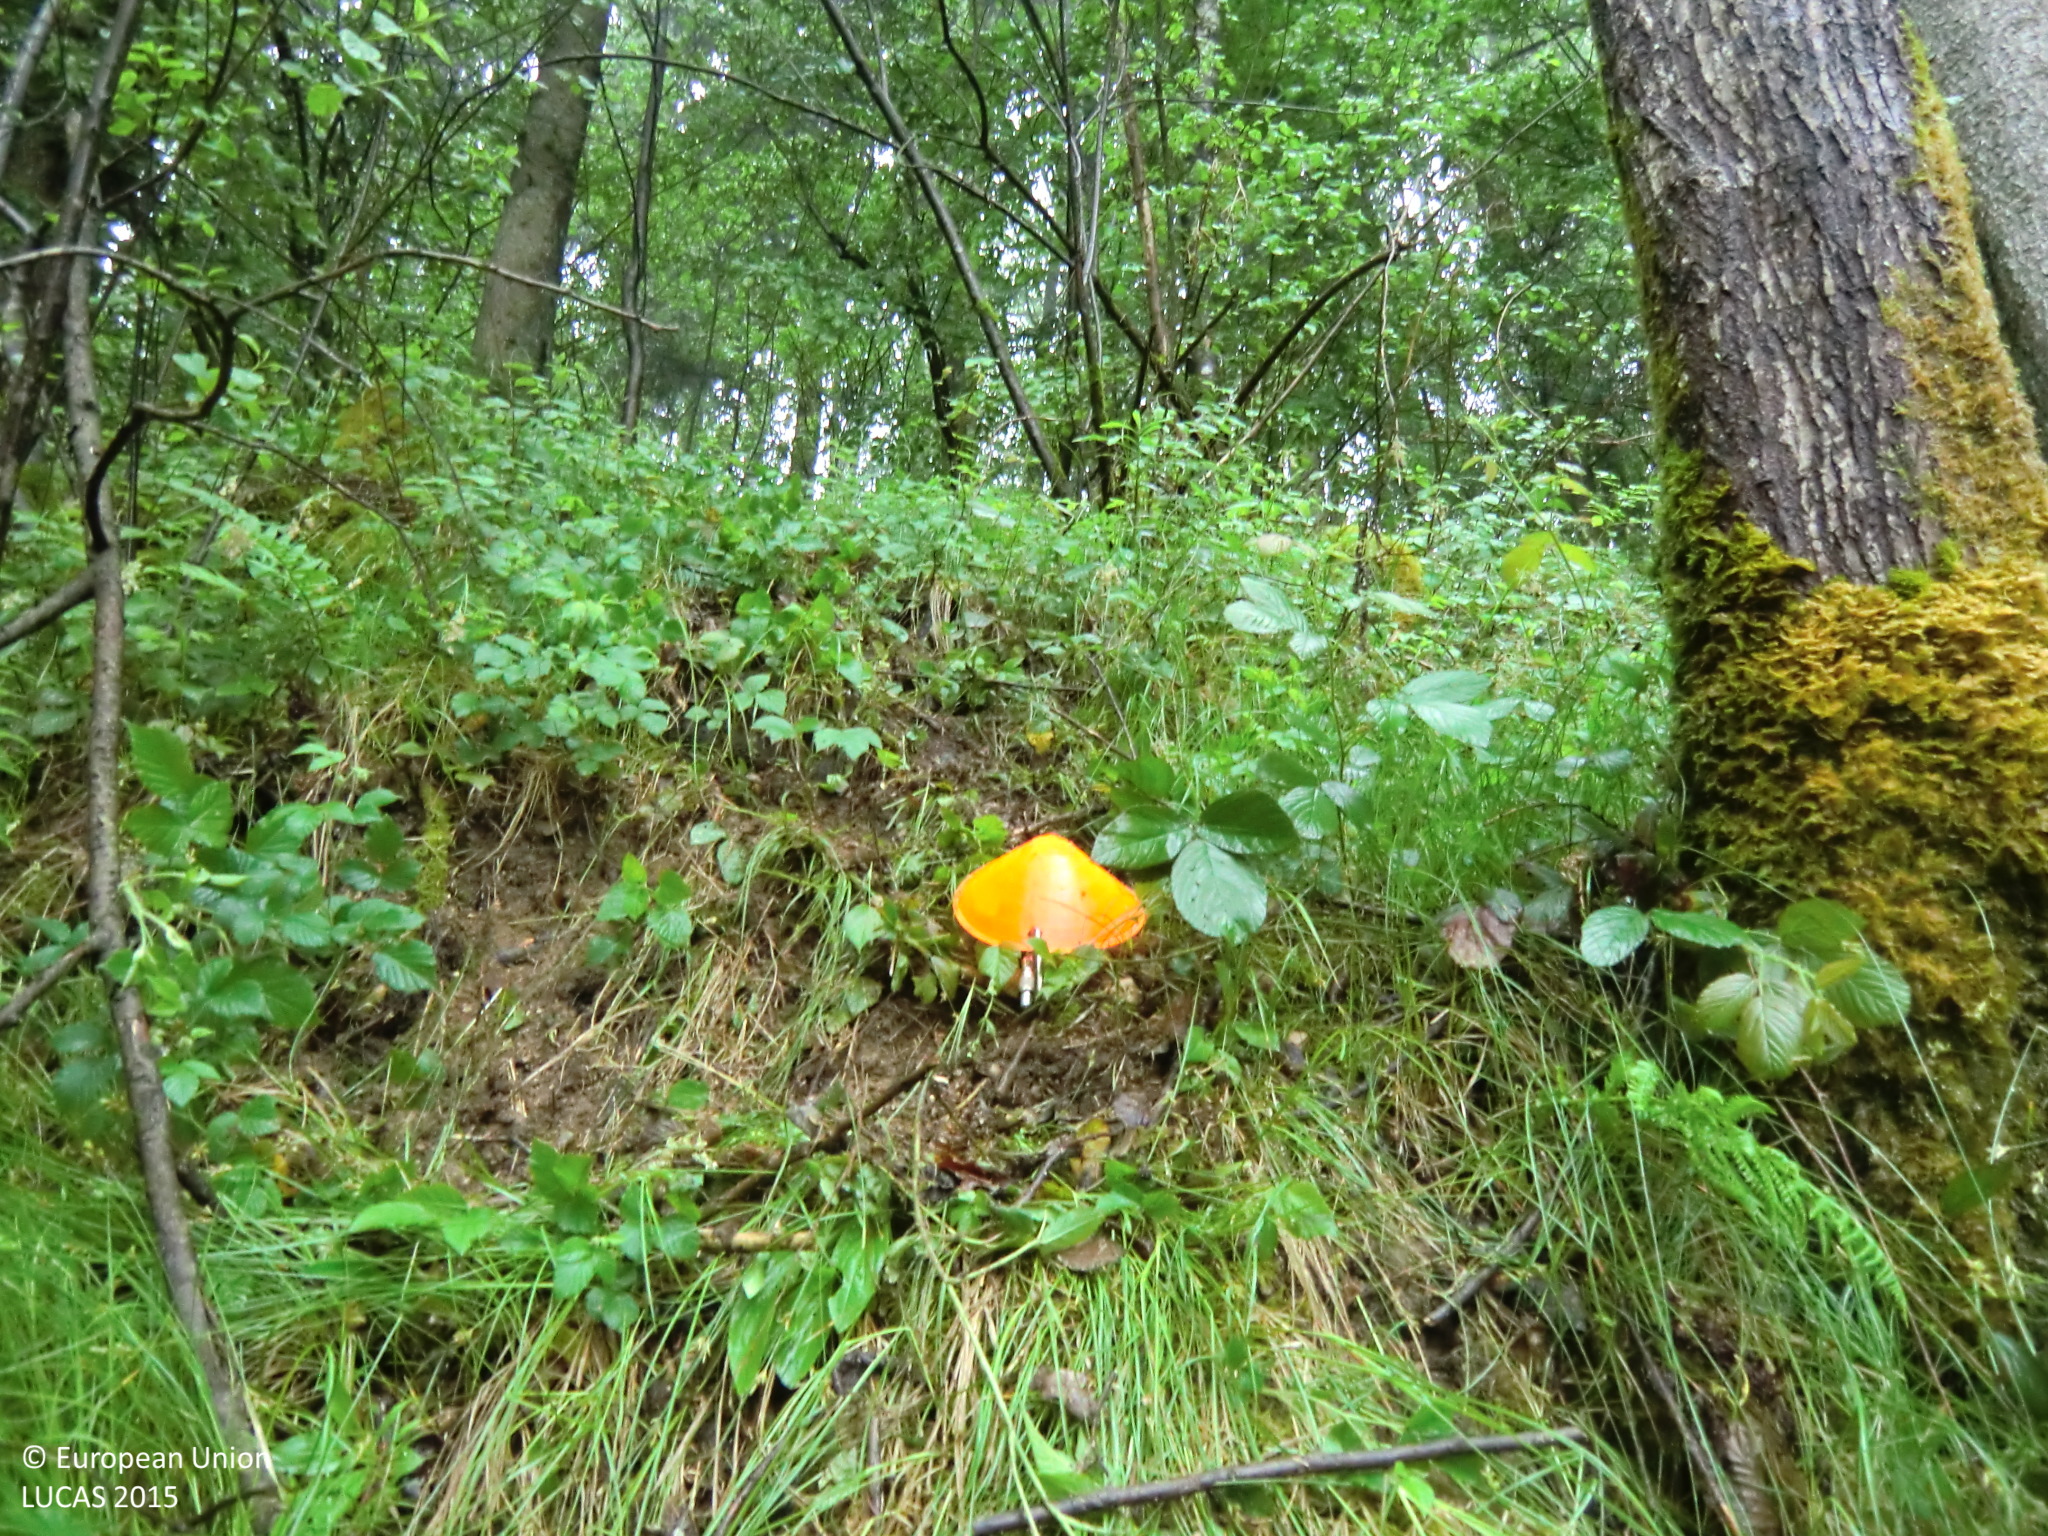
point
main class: Woodland
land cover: Spruce dominated mixed woodland
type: hemiboreal forest and nemoral coniferous forest and mixed broadleaved-coniferous forest
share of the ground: > 75 %
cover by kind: coniferous forest trees 40 %, broadleaved forest trees 40 %, herbaceous plants 20 %
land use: Forestry
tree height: > 5 m
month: May
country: AT
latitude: 48.3629
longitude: 14.5762
